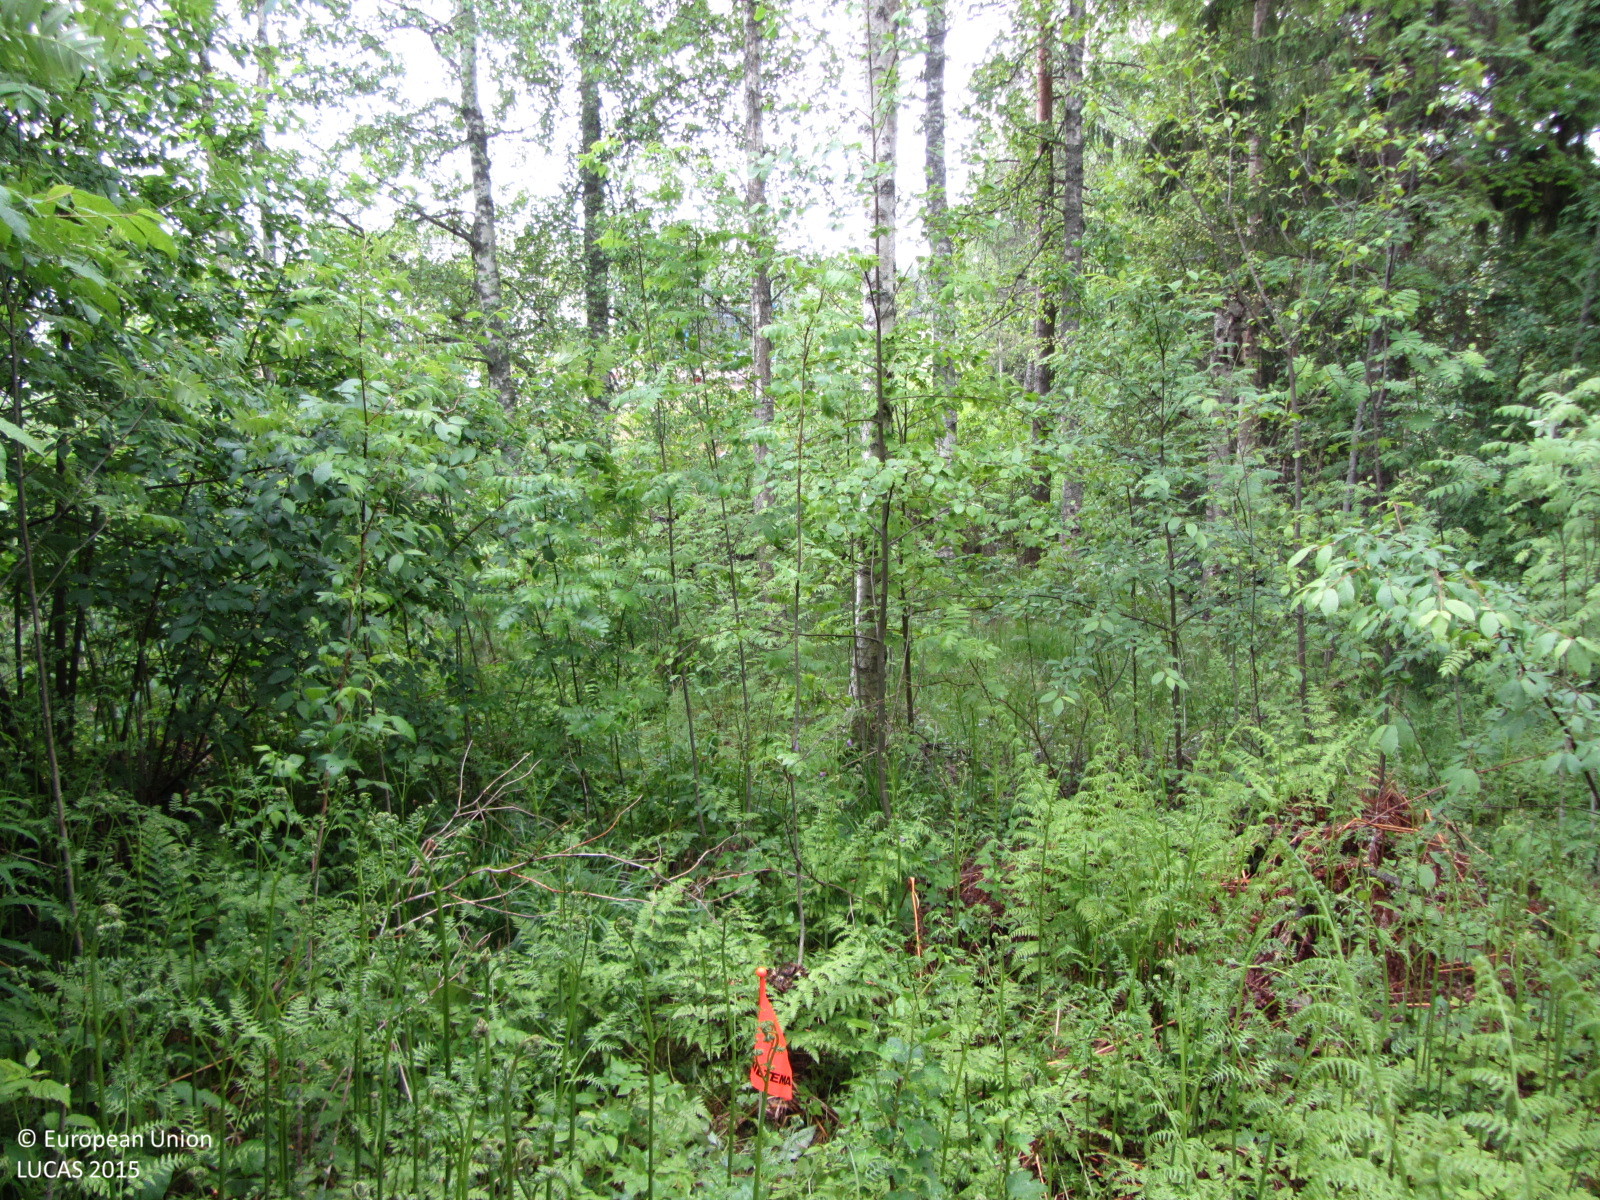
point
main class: Woodland
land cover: Other mixed woodland
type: boreal forest
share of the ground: 50 - 75 %
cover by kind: broadleaved forest trees 40 %, herbaceous plants 35 %, coniferous forest trees 25 %
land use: Forestry
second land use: Residential
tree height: > 5 m
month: June
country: FI
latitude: 60.4327
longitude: 24.7000
